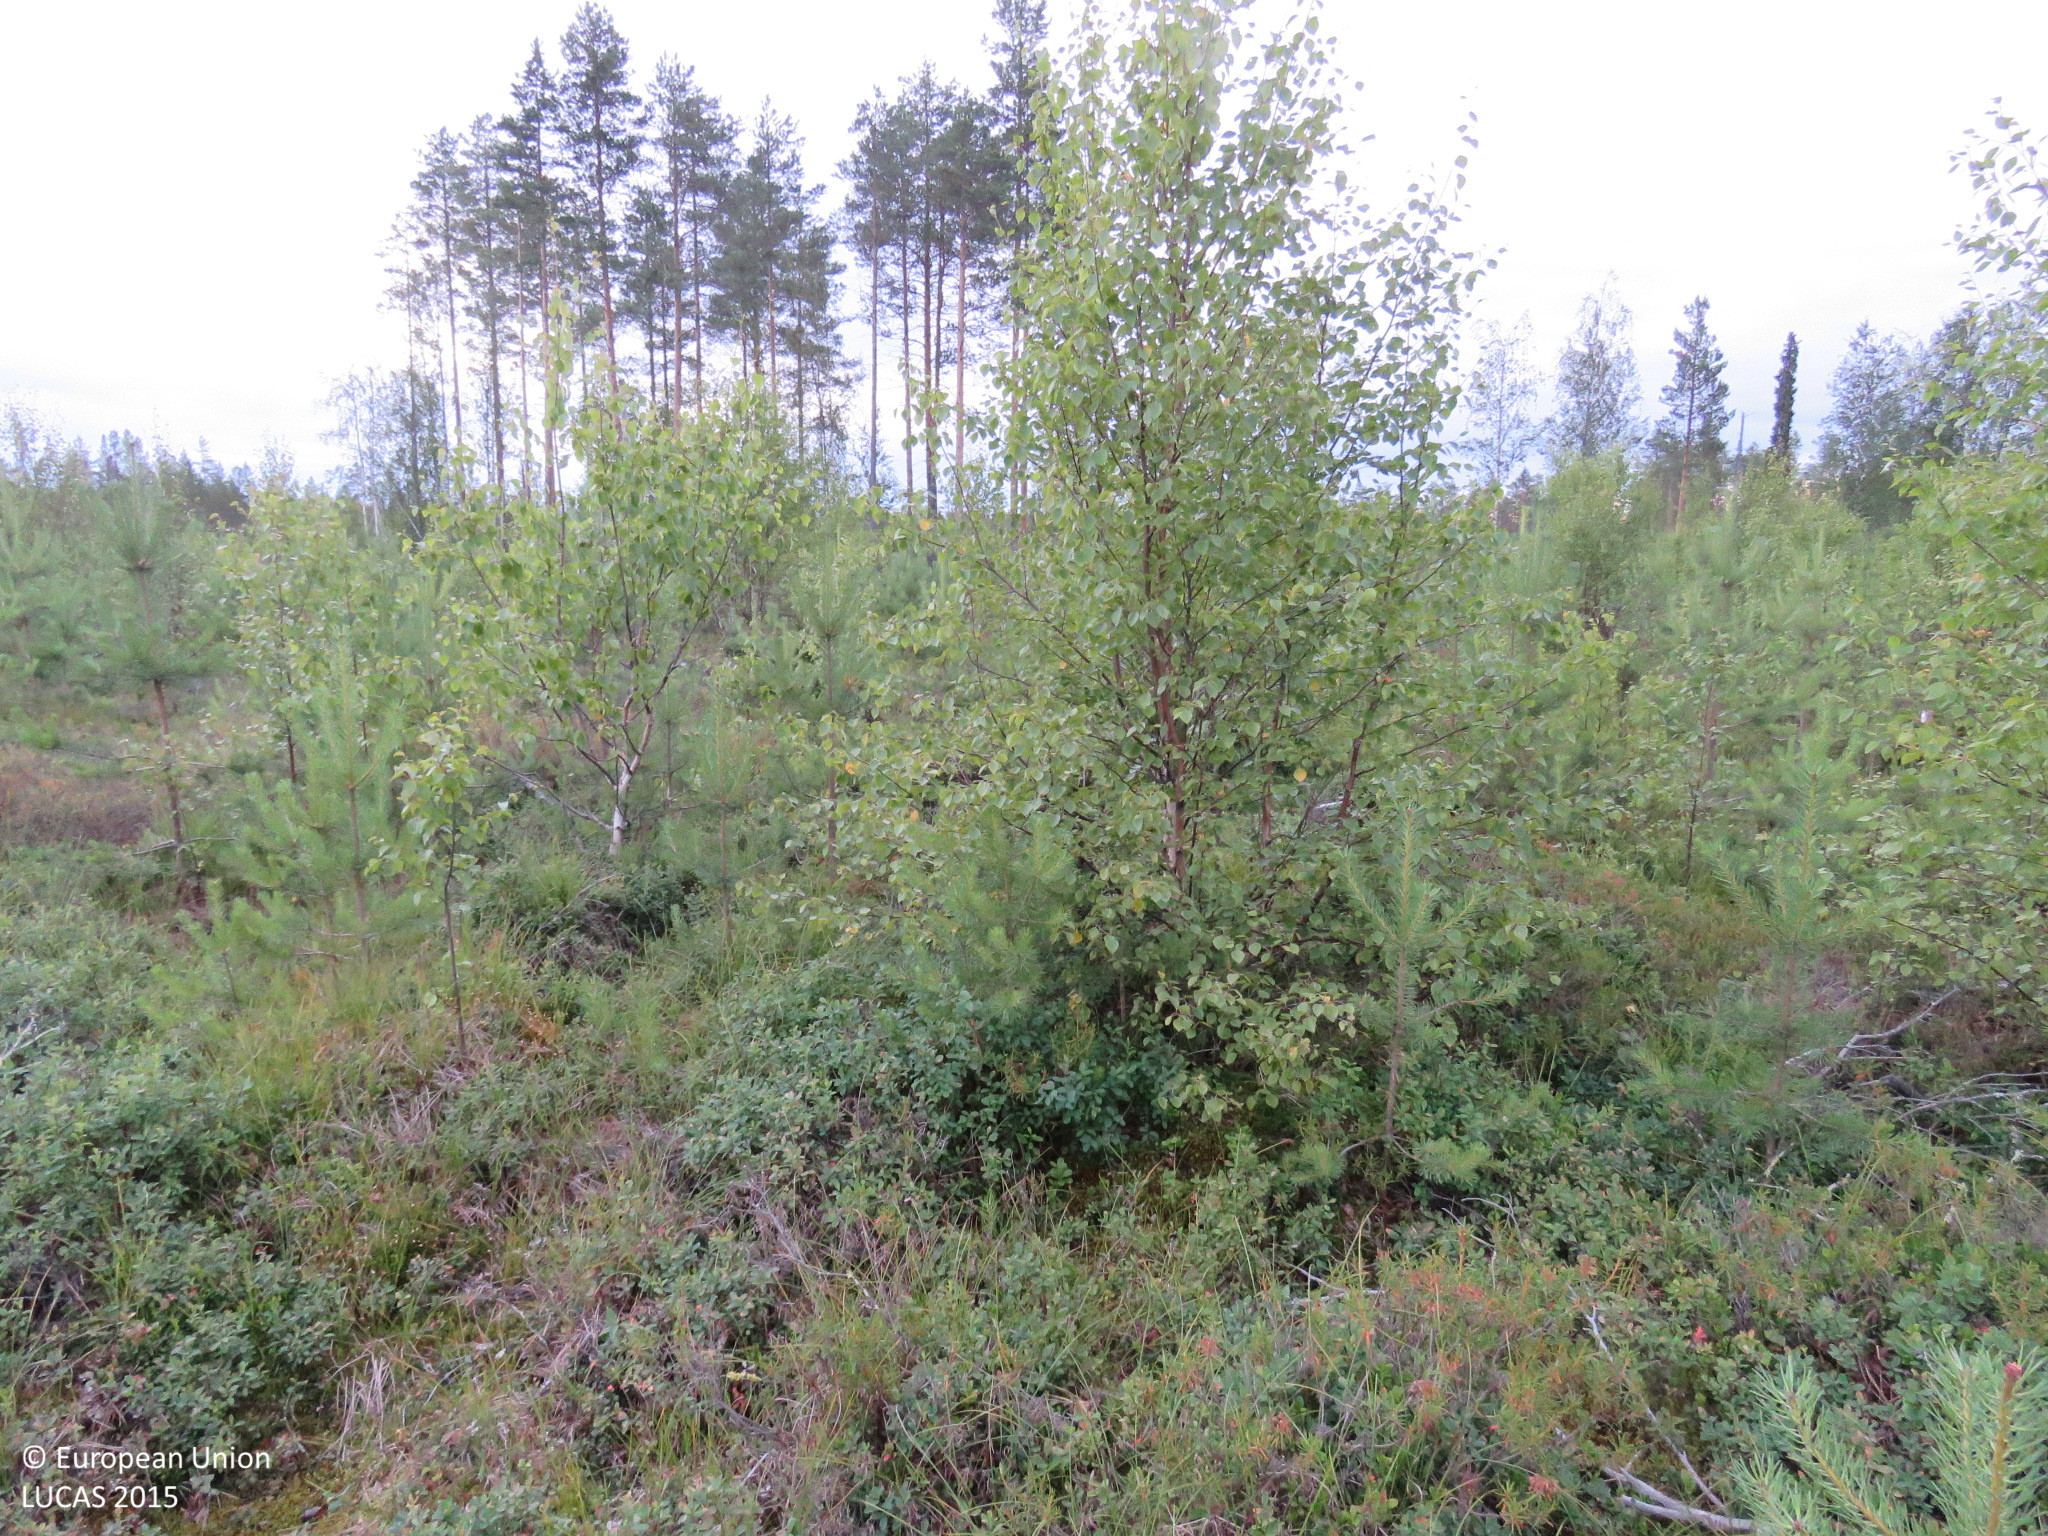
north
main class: Woodland
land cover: Pine dominated mixed woodland
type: boreal forest
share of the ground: 50 - 75 %
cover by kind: coniferous forest trees 30 %, broadleaved forest trees 30 %, shrubs 20 %, lichens and mosses 15 %, herbaceous plants 5 %
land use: Forestry
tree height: < 5 m
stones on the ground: < 10 %
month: July
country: FI
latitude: 64.6865
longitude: 26.5687
